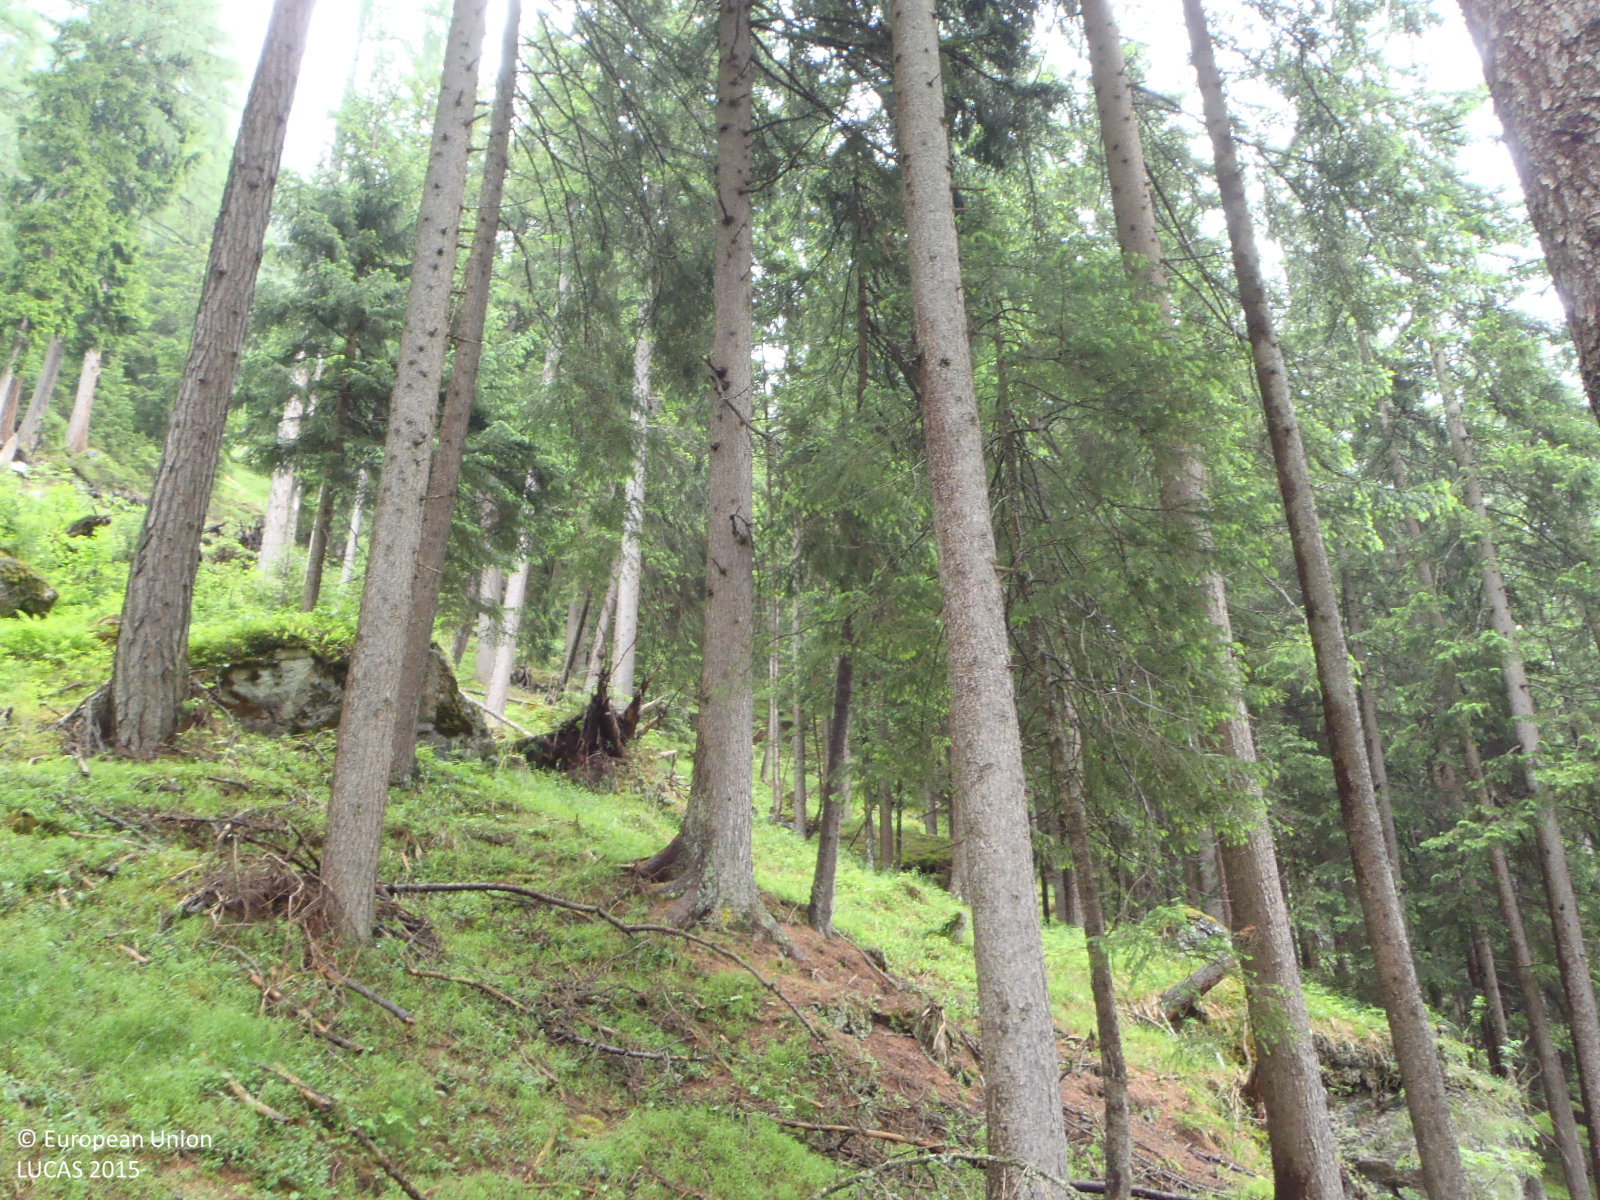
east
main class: Woodland
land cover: Spruce dominated coniferous woodland
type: alpine coniferous forest
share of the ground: > 75 %
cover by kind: coniferous forest trees 90 %, herbaceous plants 10 %
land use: Forestry
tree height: > 5 m
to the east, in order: Spruce dominated coniferous woodland; Rock outcrops; Grassland without tree/shrub cover; Rock outcrops; Spruce dominated mixed woodland
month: June
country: AT
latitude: 47.1919
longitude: 13.6012
